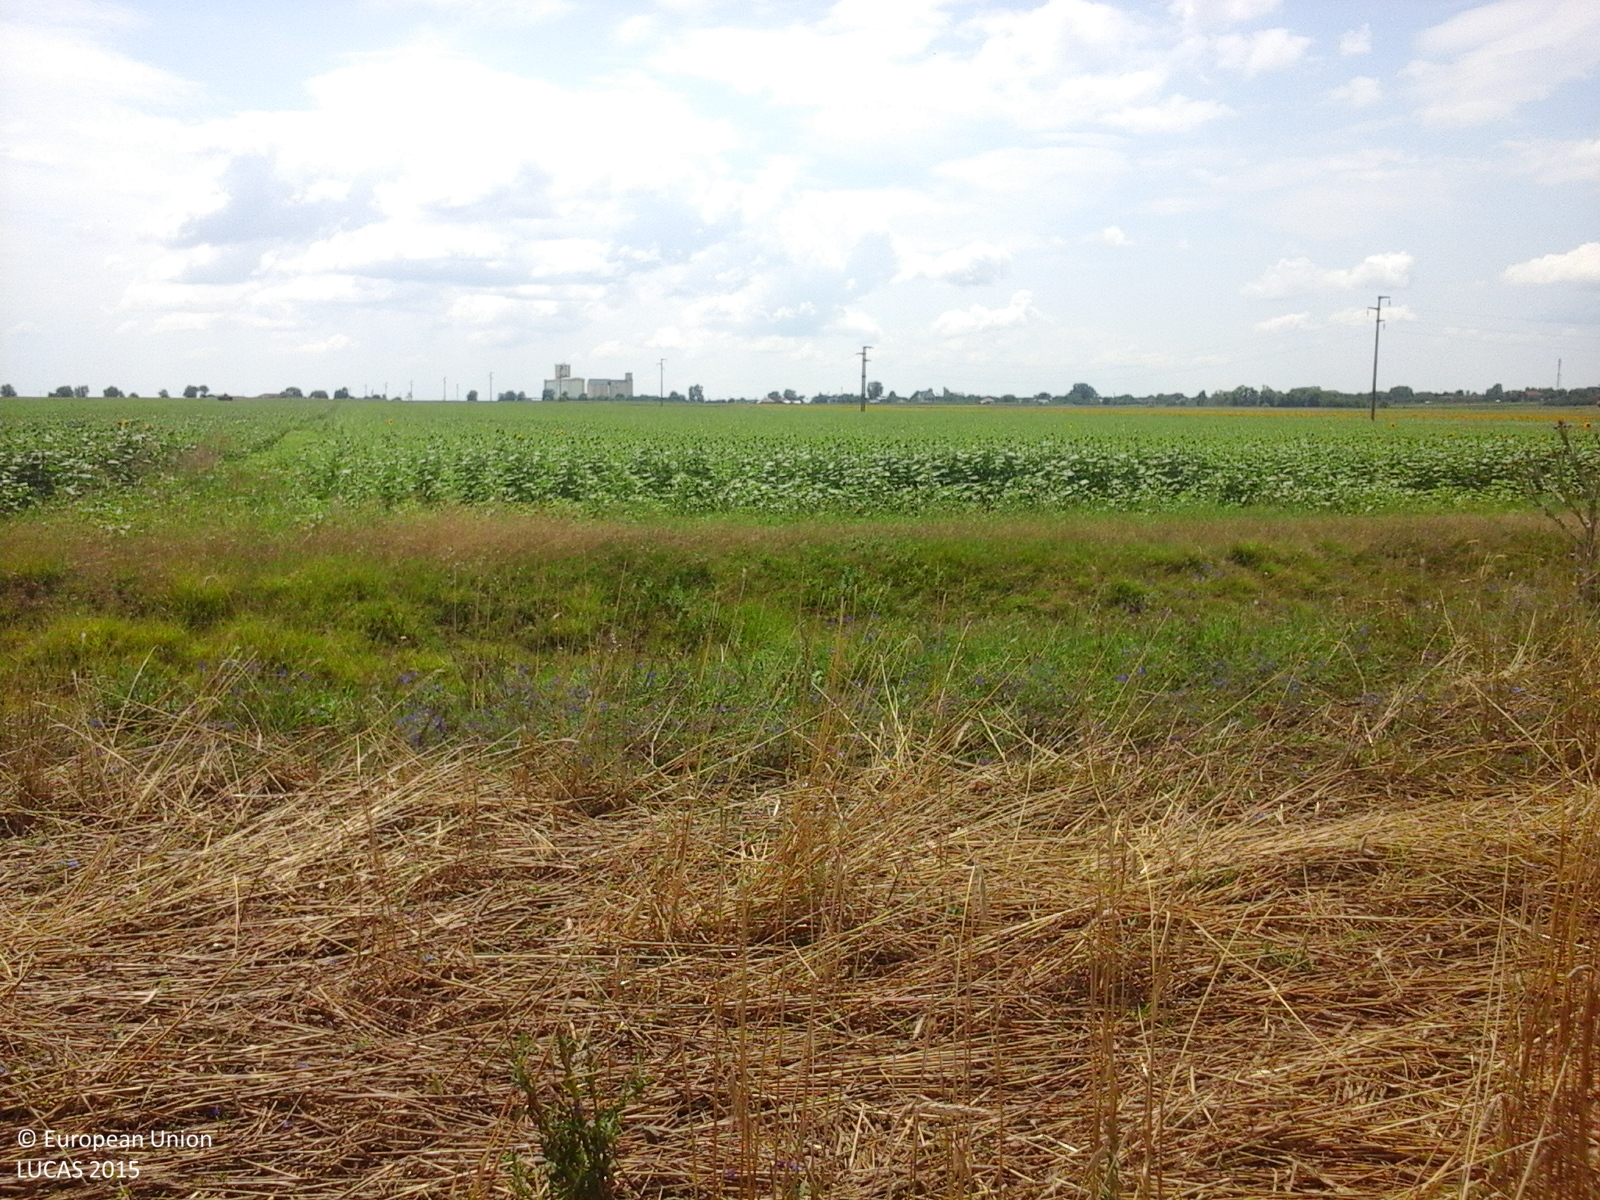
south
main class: Cropland
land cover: Rye
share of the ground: > 75 %
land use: Agriculture (excluding fallow land and kitchen gardens)
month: July
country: RO
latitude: 44.0139
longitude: 24.4225
